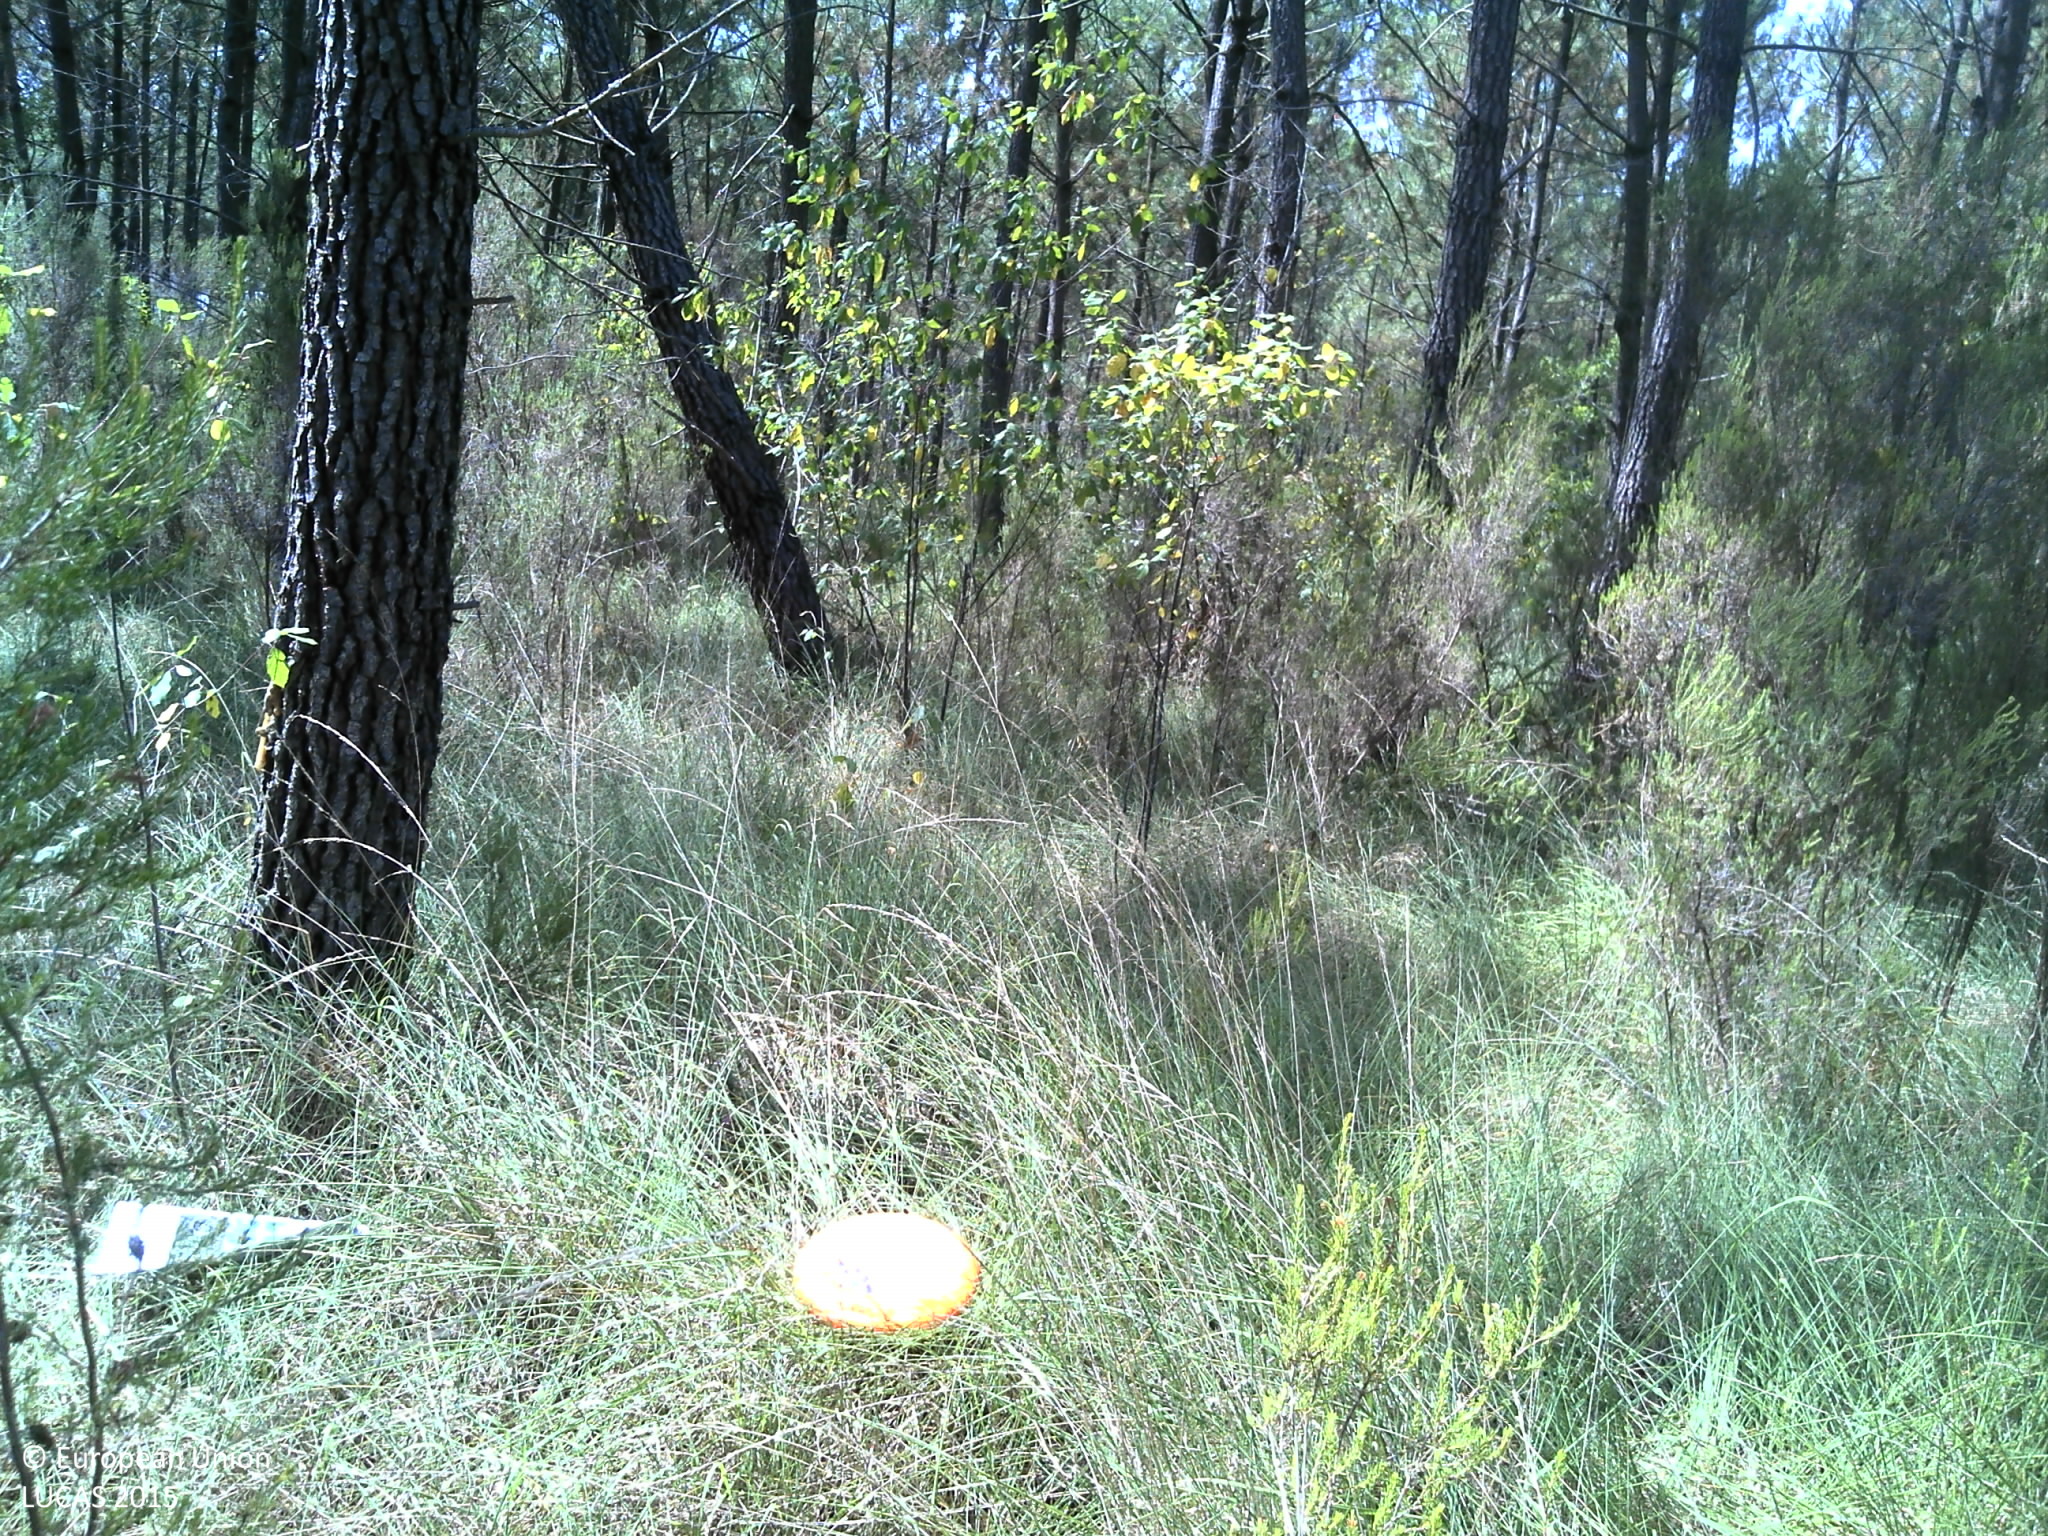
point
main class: Woodland
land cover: Pine dominated coniferous woodland
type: coniferous forest of the mediterranean region
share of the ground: > 75 %
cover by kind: coniferous forest trees 70 %, shrubs 20 %, herbaceous plants 10 %
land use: Forestry
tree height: > 5 m
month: July
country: FR
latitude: 44.5942
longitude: -0.7134
